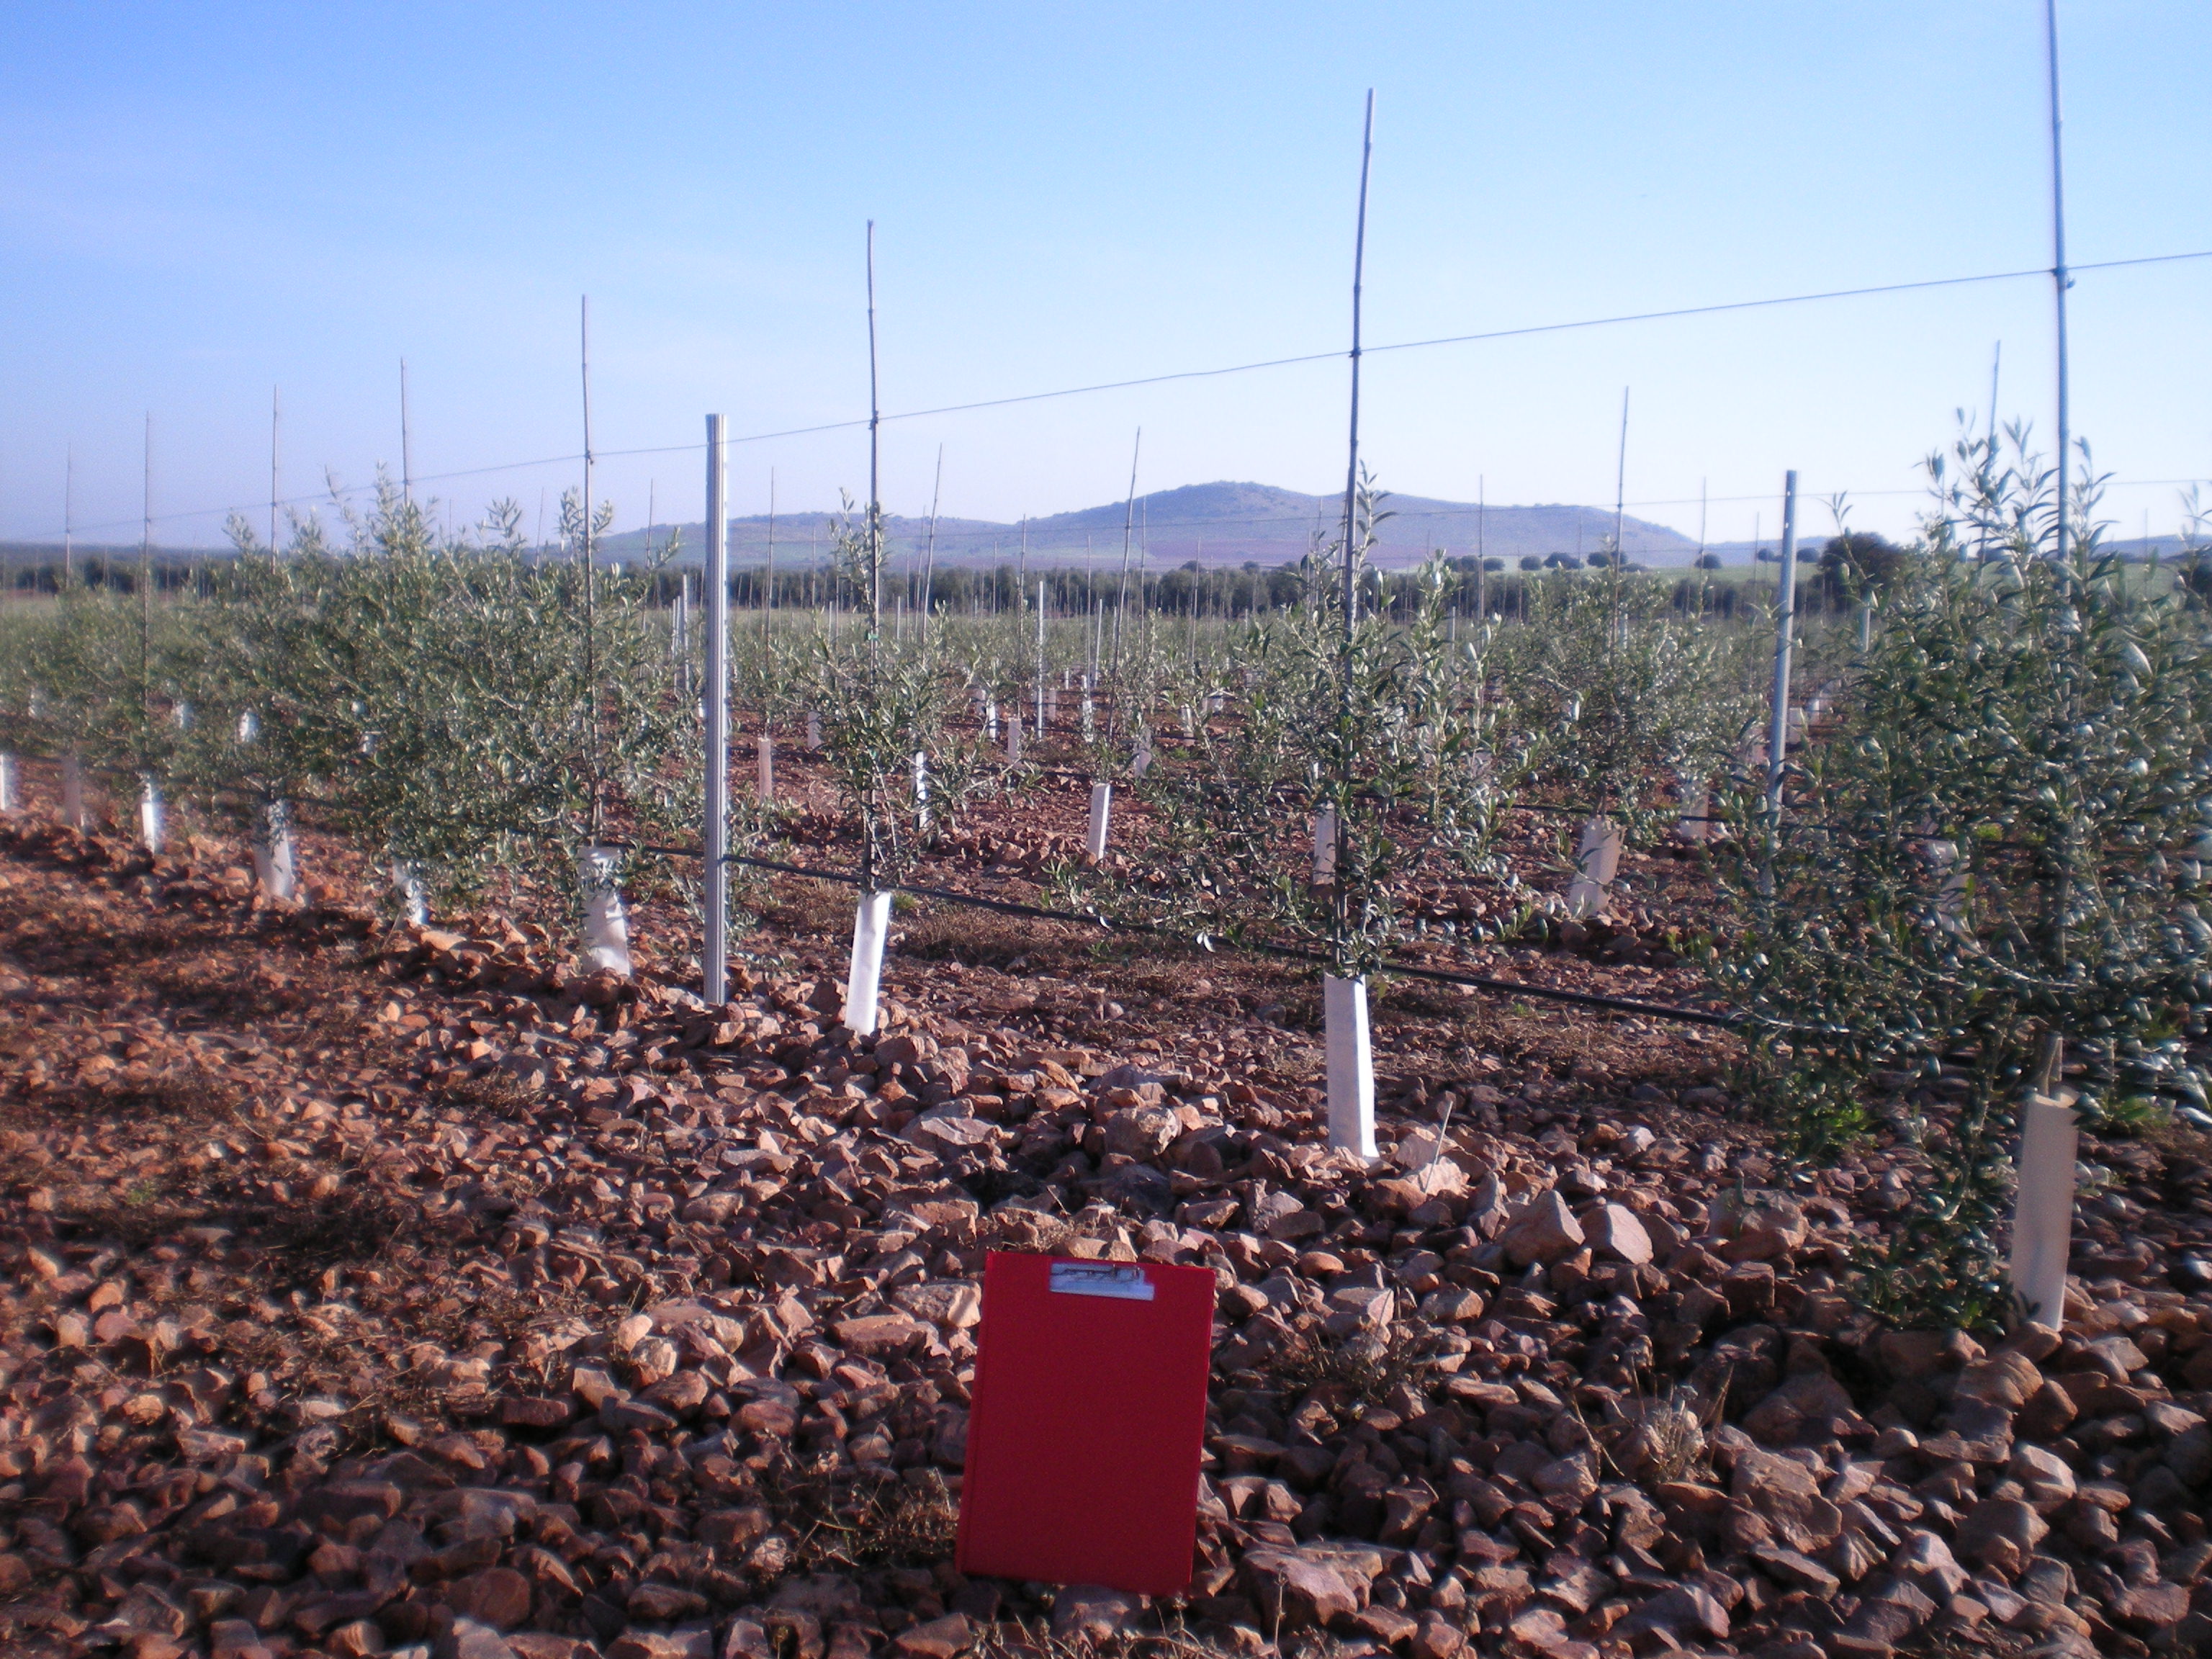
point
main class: Cropland
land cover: Olive groves
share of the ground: 10 - 25 %
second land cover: Other bare soil
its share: > 75 %
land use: Agriculture (excluding fallow land and kitchen gardens)
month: April
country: ES
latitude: 38.8781
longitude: -3.5821
